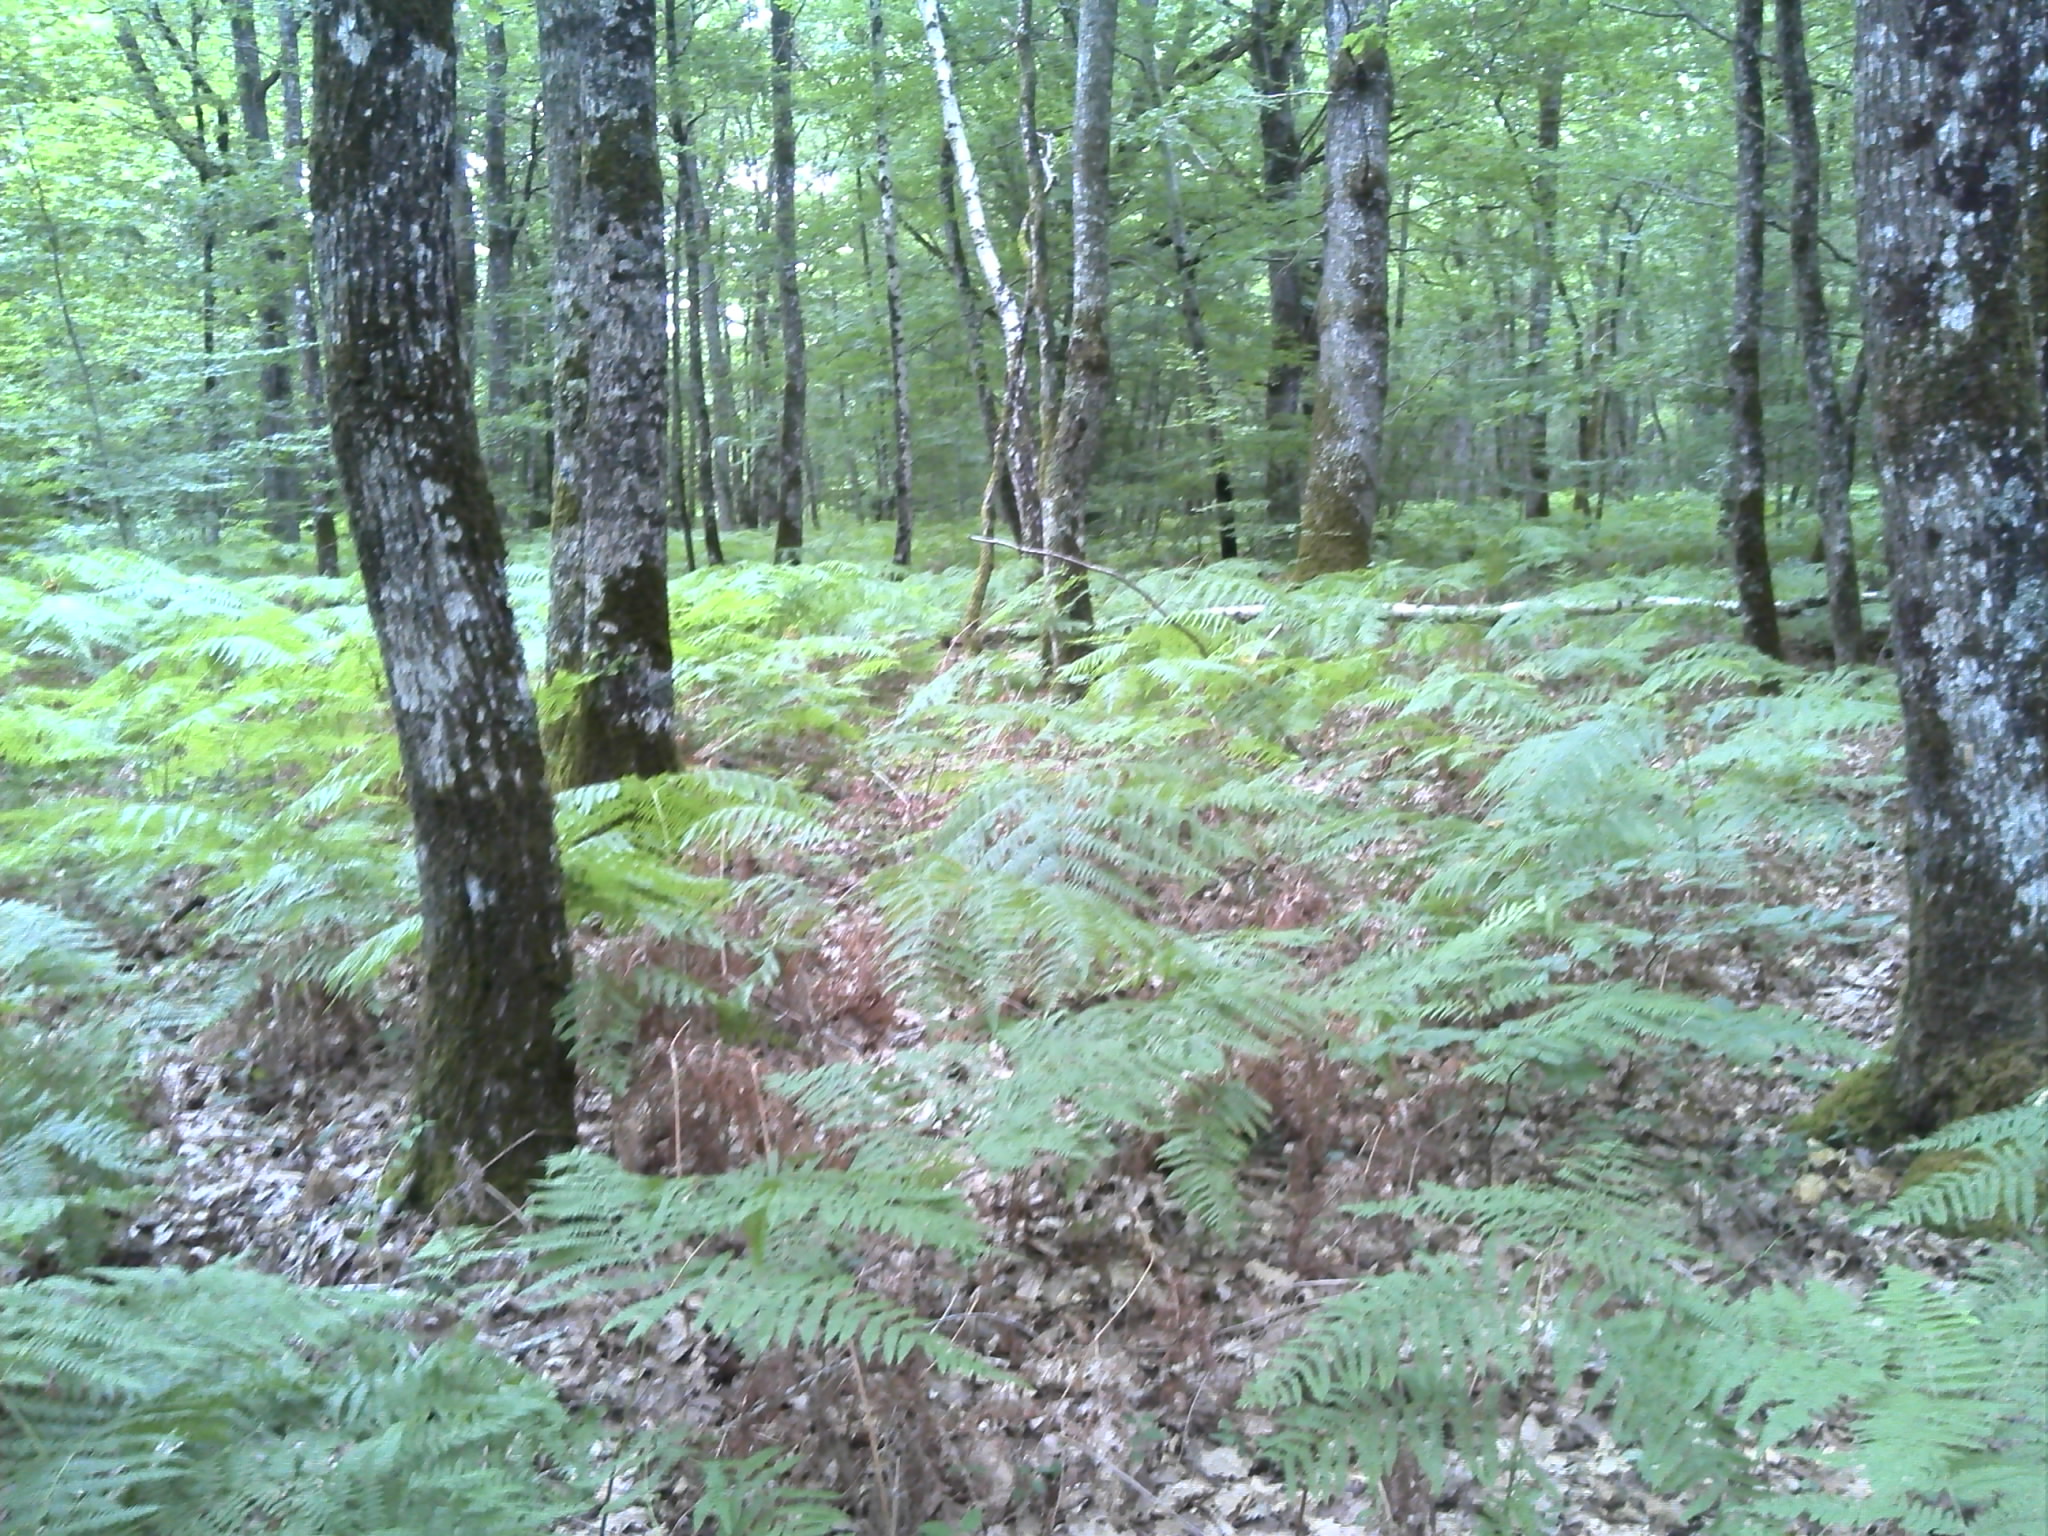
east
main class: Woodland
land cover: Broadleaved woodland
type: beech forest
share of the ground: > 75 %
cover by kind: broadleaved forest trees 90 %, herbaceous plants 5 %, lichens and mosses 5 %
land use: Forestry
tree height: > 5 m
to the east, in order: Broadleaved woodland; Ditches and canals; Grass margins; Paved roads, cycling and walking lanes; Grass margins; Ditches and canals; Broadleaved woodland
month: June
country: FR
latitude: 47.1734
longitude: 1.5302
